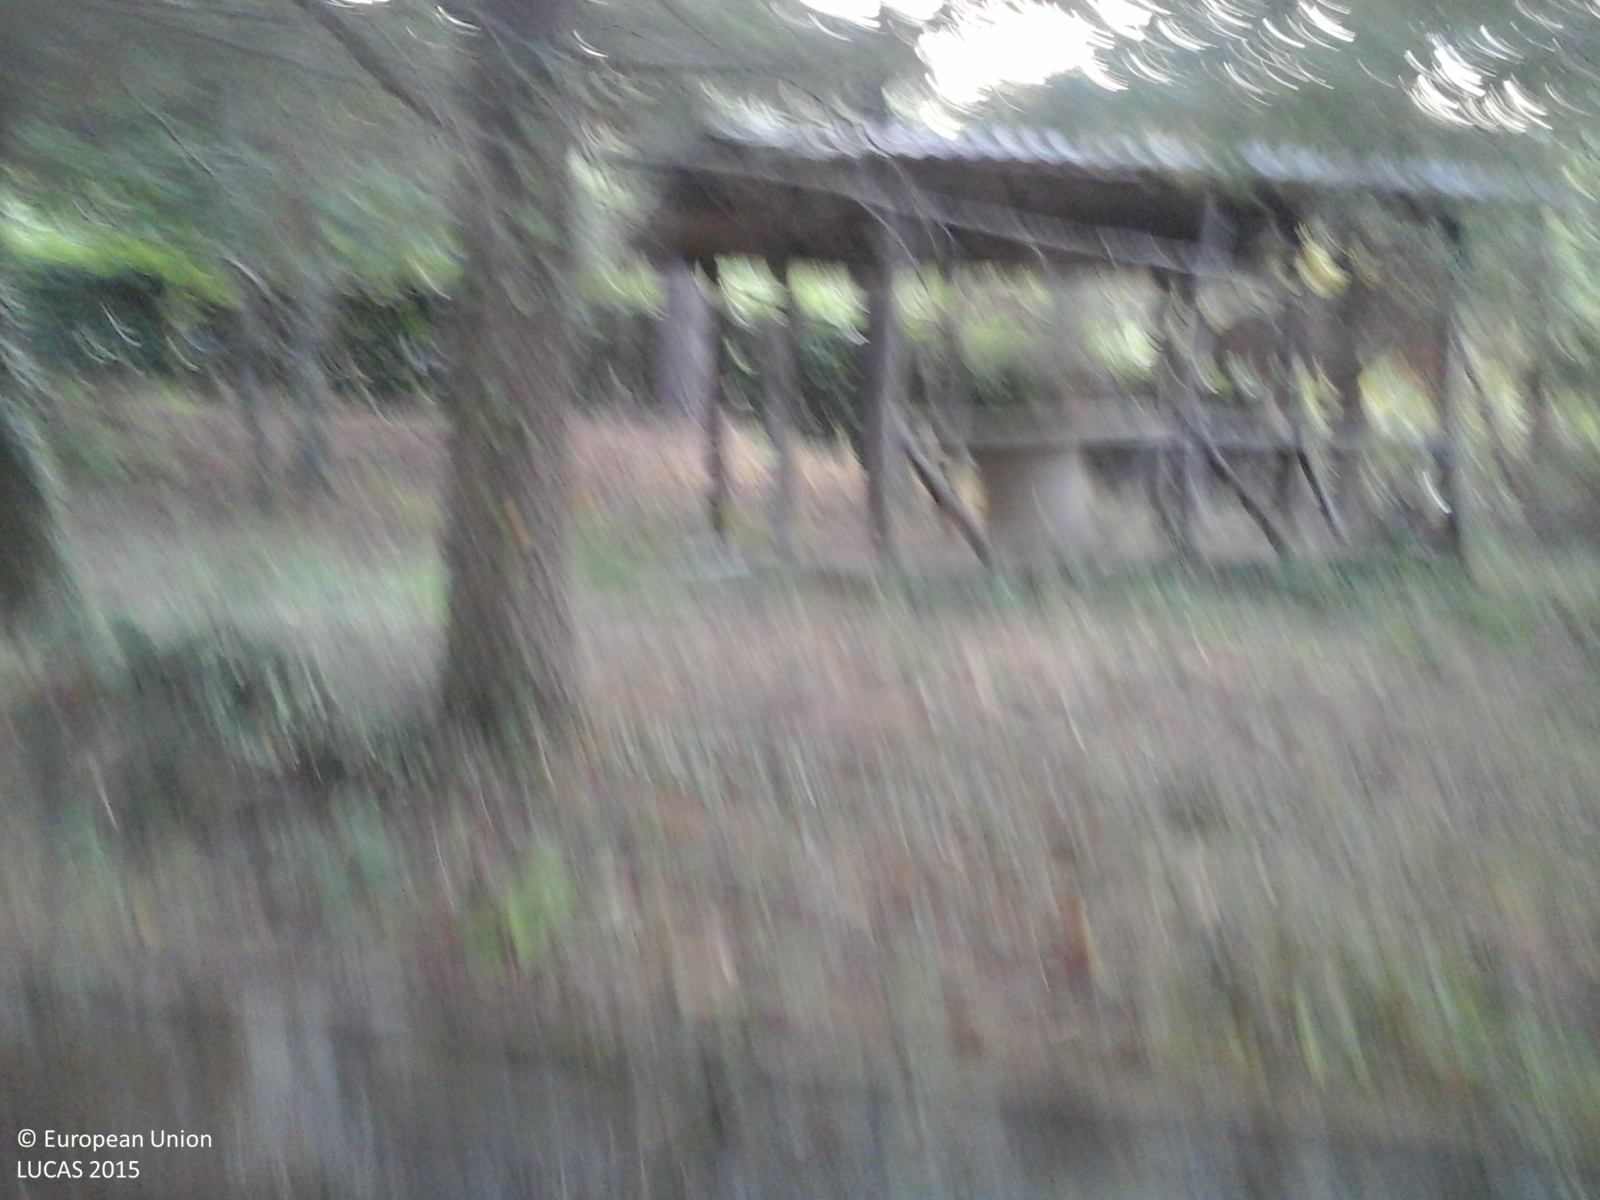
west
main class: Woodland
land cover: Other mixed woodland
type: thermophilous deciduous forest
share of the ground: > 75 %
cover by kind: broadleaved forest trees 75 %, coniferous forest trees 25 %
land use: Forestry
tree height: > 5 m
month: August
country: IT
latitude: 43.9157
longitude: 10.6335
